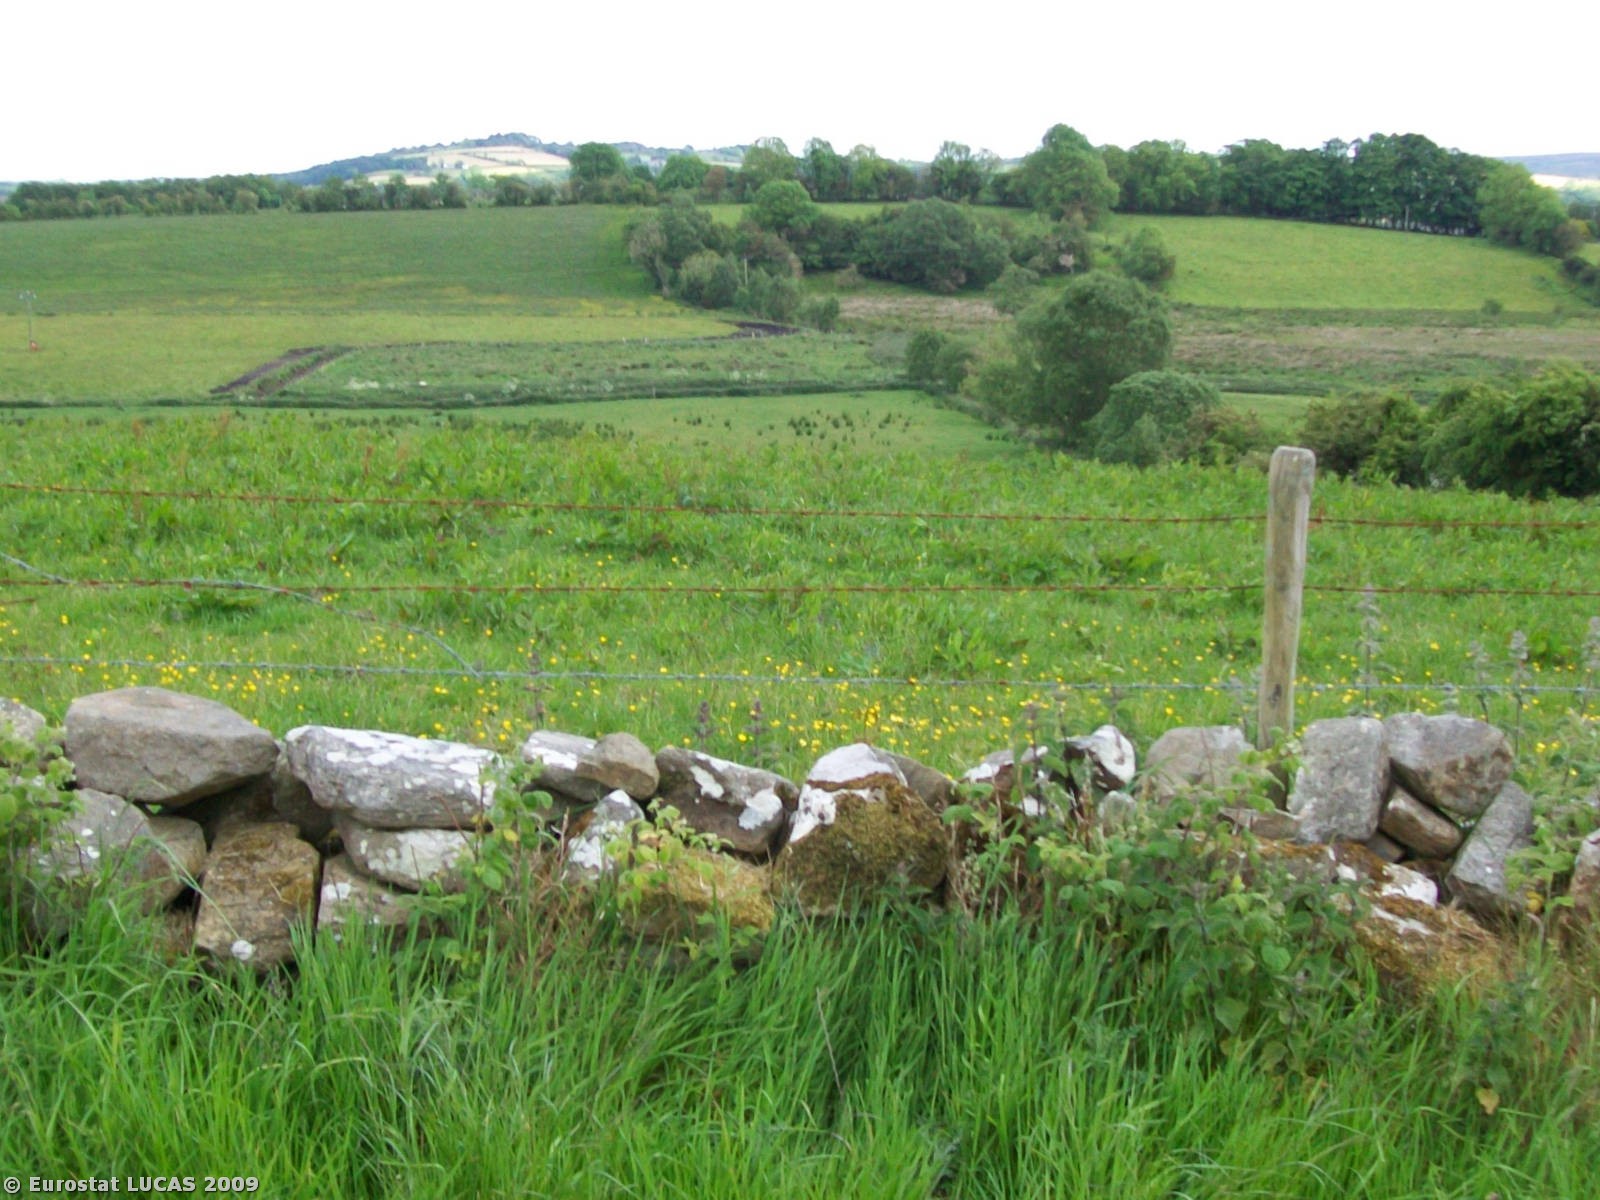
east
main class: Grassland
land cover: Grassland without tree/shrub cover
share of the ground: > 75 %
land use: Agriculture (excluding fallow land and kitchen gardens)
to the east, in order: Grassland without tree/shrub cover; Fences; Electric lines; Paved roads, cycling and walking lanes; Fences; Grassland without tree/shrub cover
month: June
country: GB
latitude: 54.6393
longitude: -7.4931
